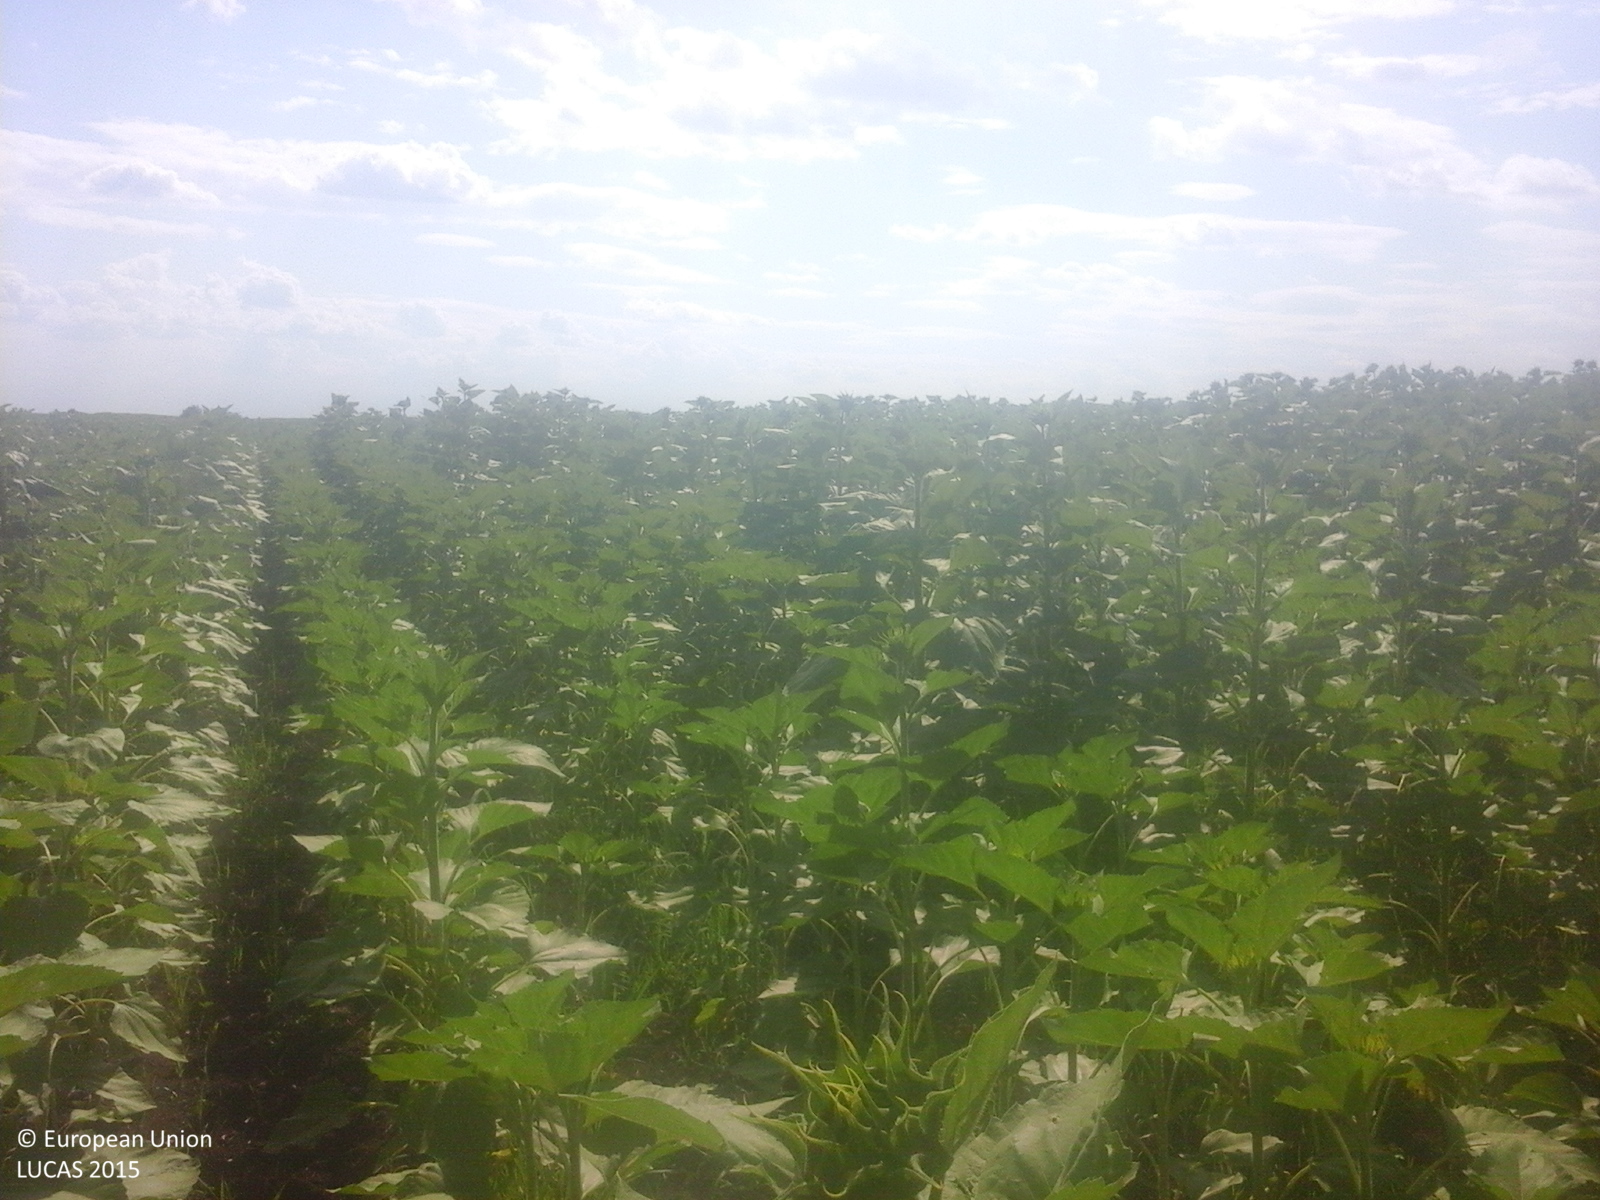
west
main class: Cropland
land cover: Sunflower
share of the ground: > 75 %
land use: Agriculture (excluding fallow land and kitchen gardens)
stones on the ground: < 10 %
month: July
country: RO
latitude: 44.0822
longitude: 25.4596
